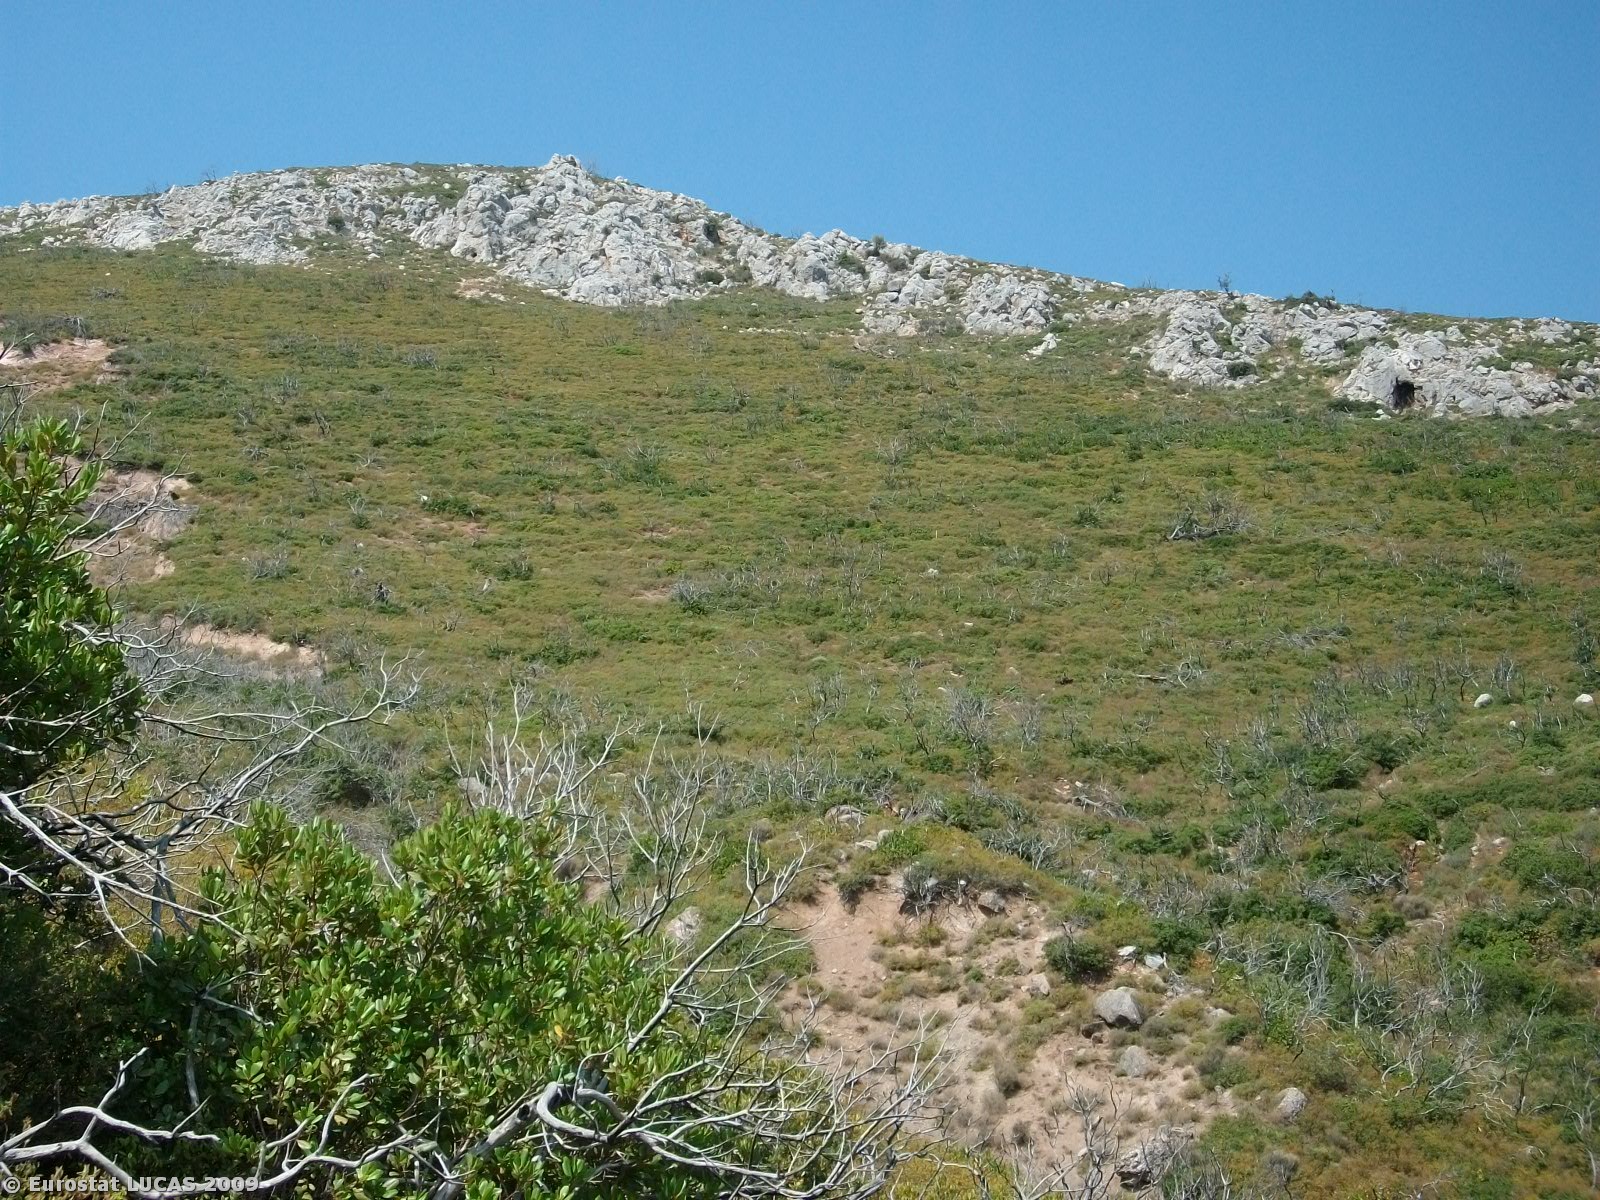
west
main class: Shrubland
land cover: Shrubland without tree cover
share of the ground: > 75 %
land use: Unused
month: August
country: GR
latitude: 38.6143
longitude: 23.1100
